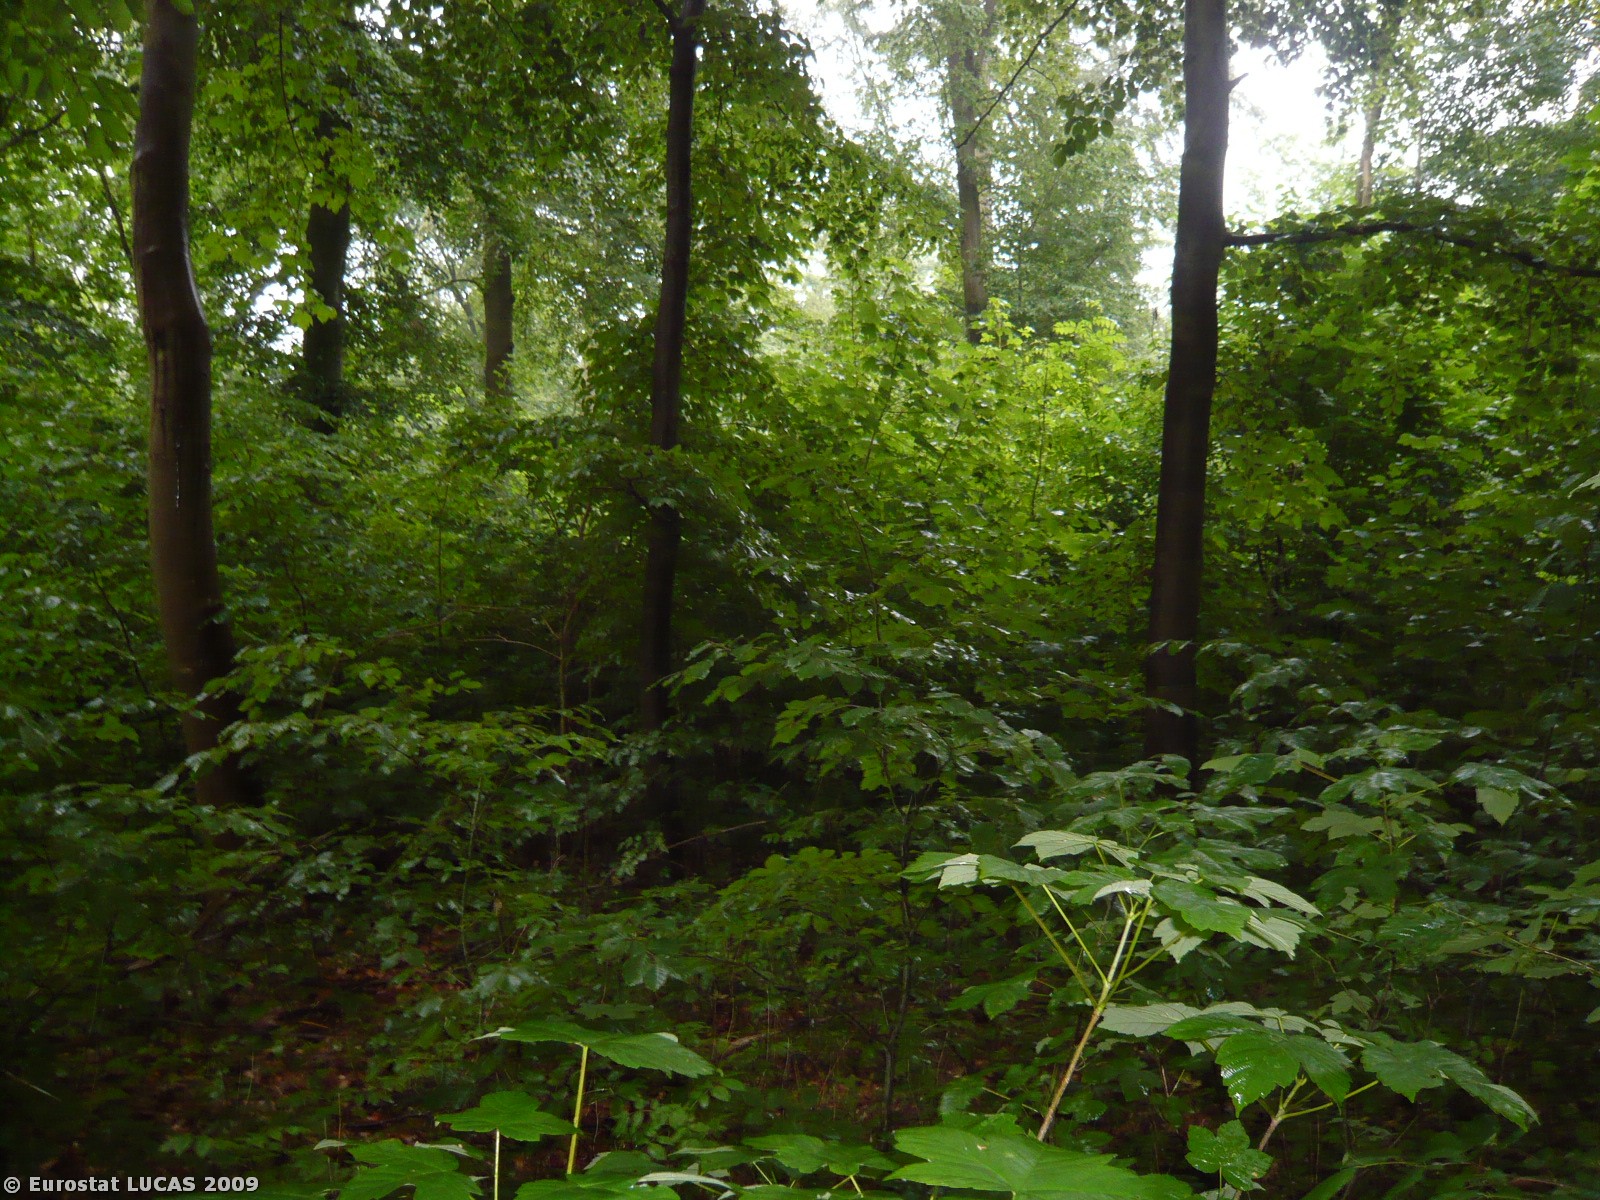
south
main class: Woodland
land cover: Broadleaved woodland
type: mesophytic deciduous forest
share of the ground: > 75 %
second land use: Amenities, museums, leisure
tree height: > 5 m
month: June
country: DK
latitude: 54.7914
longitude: 11.7563
